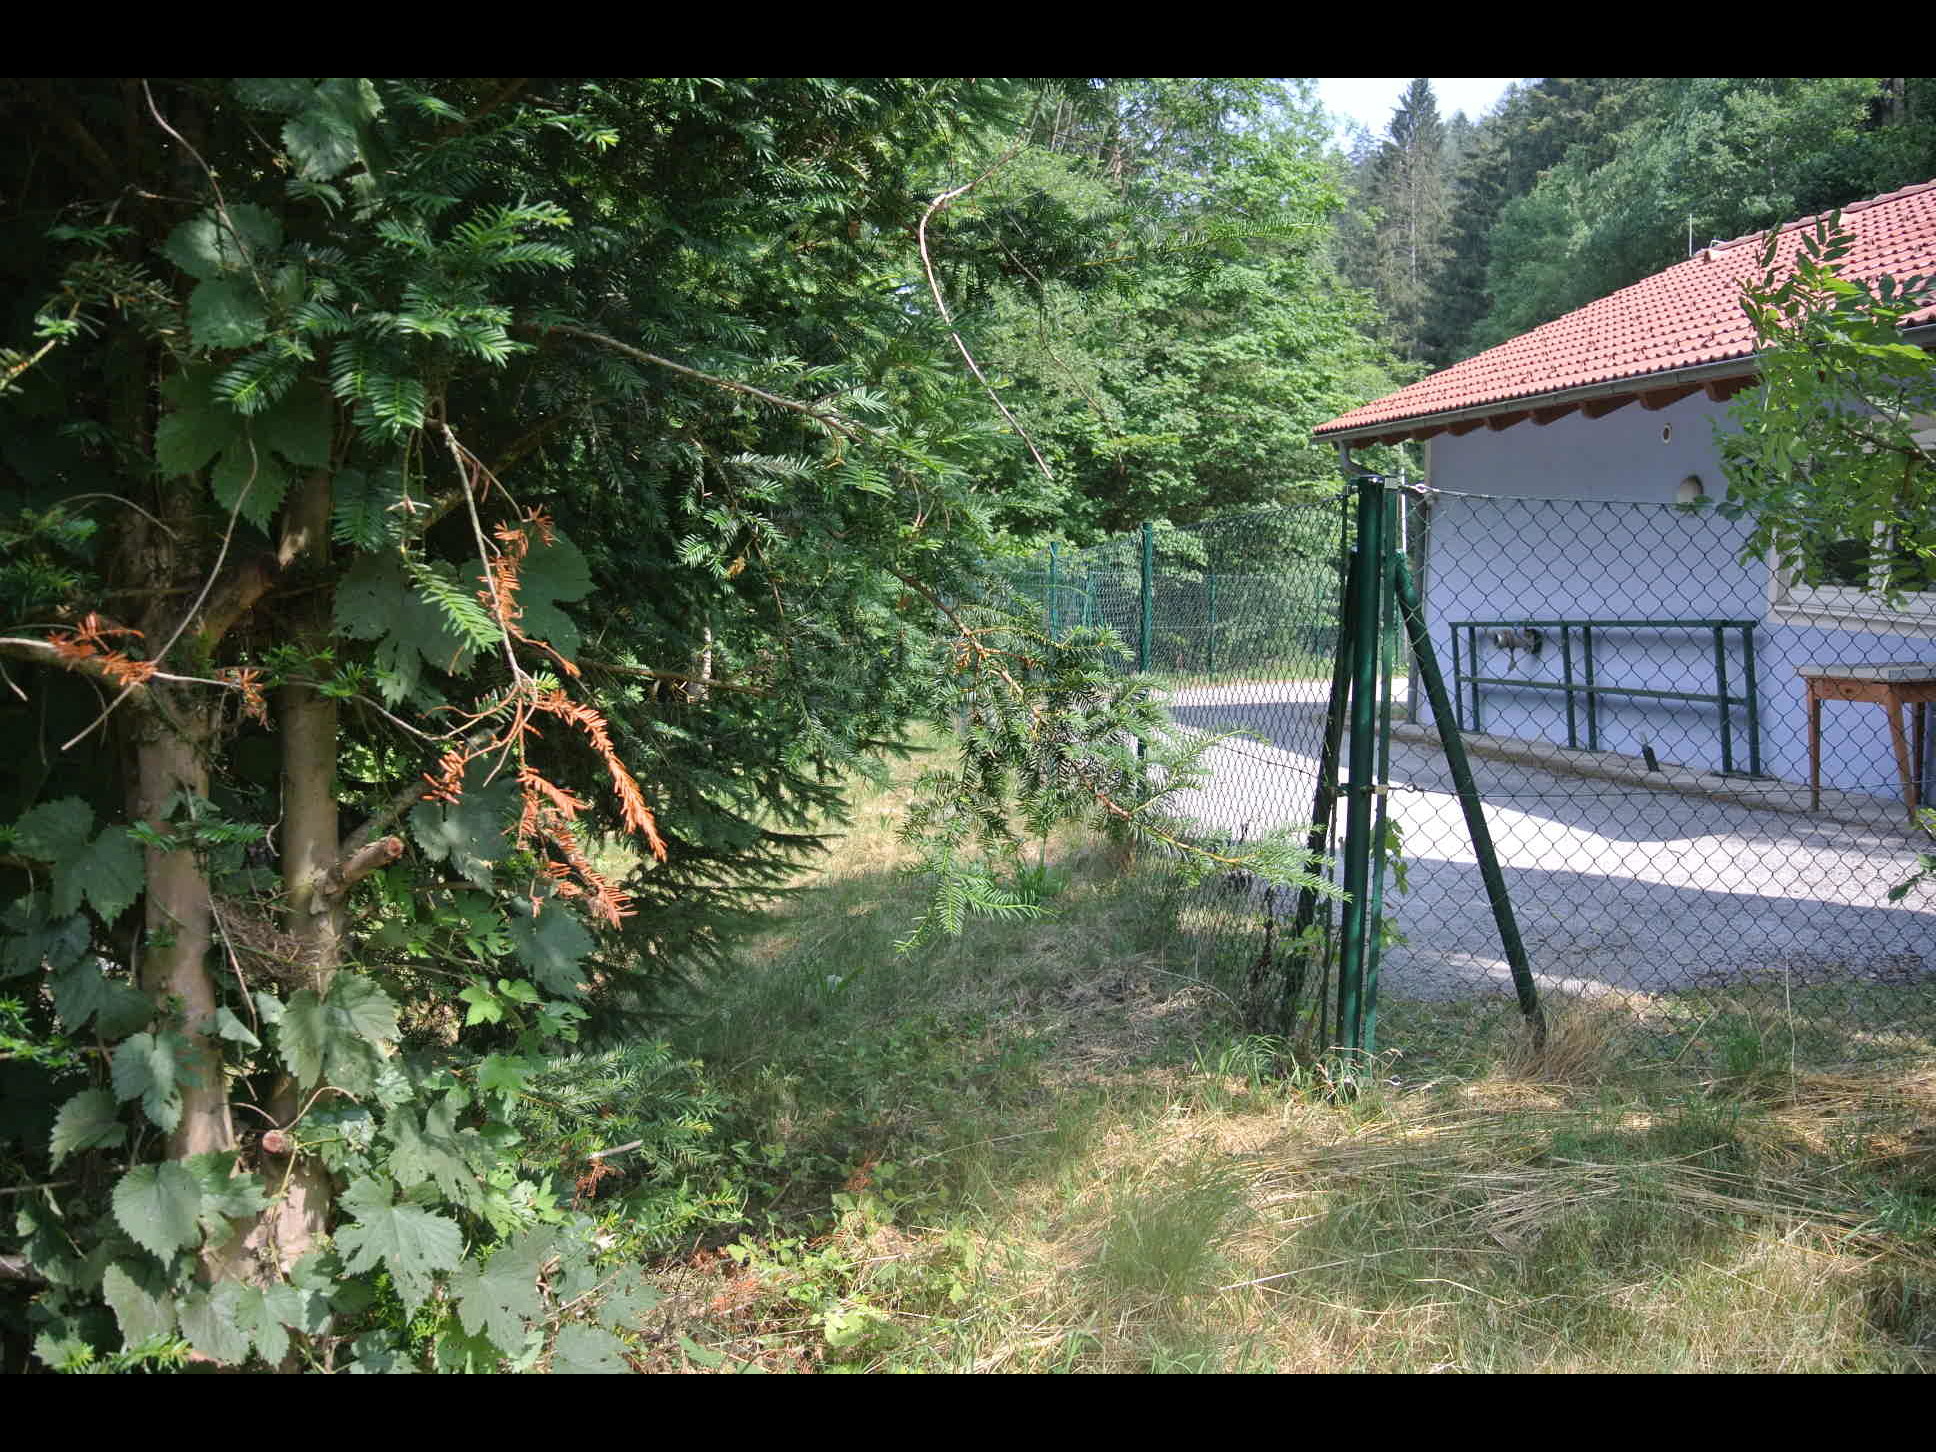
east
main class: Grassland
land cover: Grassland with sparse tree/shrub cover
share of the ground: > 75 %
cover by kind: herbaceous plants 90 %, broadleaved forest trees 5 %, shrubs 5 %
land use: Amenities, museums, leisure
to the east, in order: Grassland with sparse tree/shrub cover; Broadleaved woodland; Inland fresh running water; Broadleaved woodland; Fences; Grassland without tree/shrub cover; Fences; Grassland without tree/shrub cover; Fences; Grassland without tree/shrub cover
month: July
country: AT
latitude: 47.5522
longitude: 16.0487
